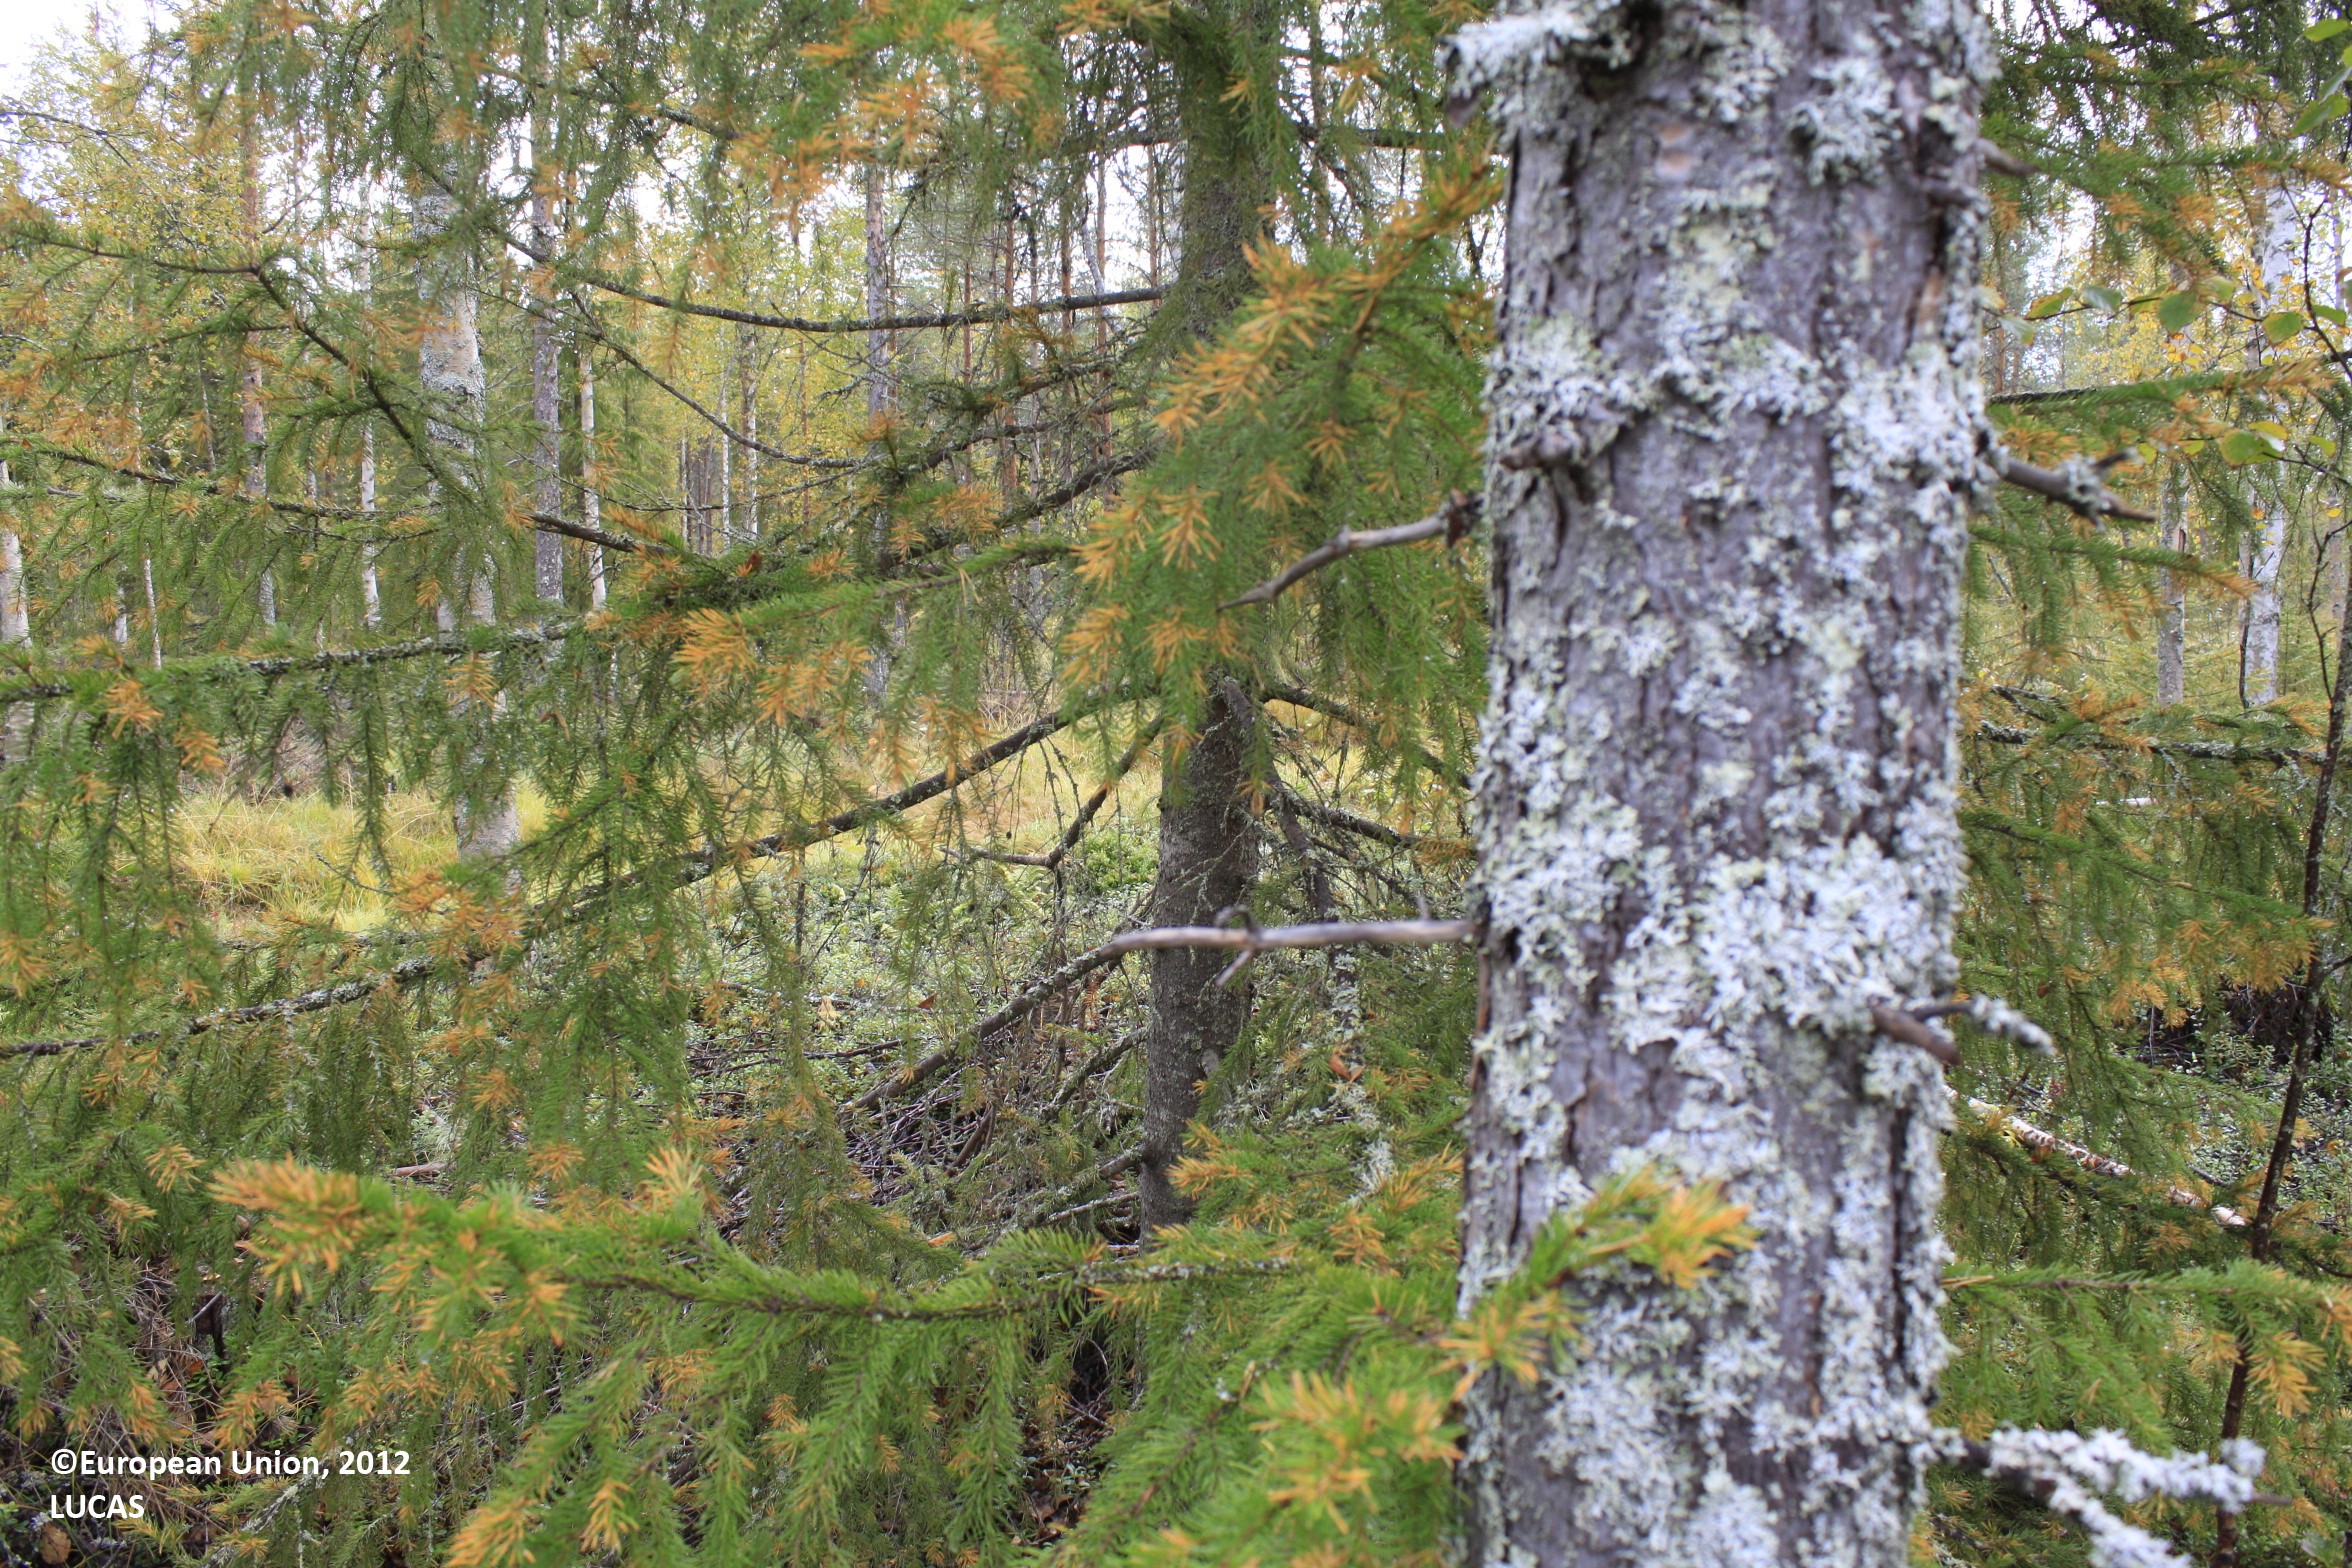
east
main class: Woodland
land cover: Pine dominated mixed woodland
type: boreal forest
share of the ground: 25 - 50 %
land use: Forestry
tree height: > 5 m
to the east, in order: Pine dominated mixed woodland; Ditches and canals; Tracks; Pine dominated mixed woodland; Ditches and canals; Pine dominated mixed woodland; Ditches and canals; Pine dominated mixed woodland; Ditches and canals; Pine dominated mixed woodland; Ditches and canals; Pine dominated mixed woodland
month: September
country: FI
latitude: 65.5406
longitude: 26.5744
